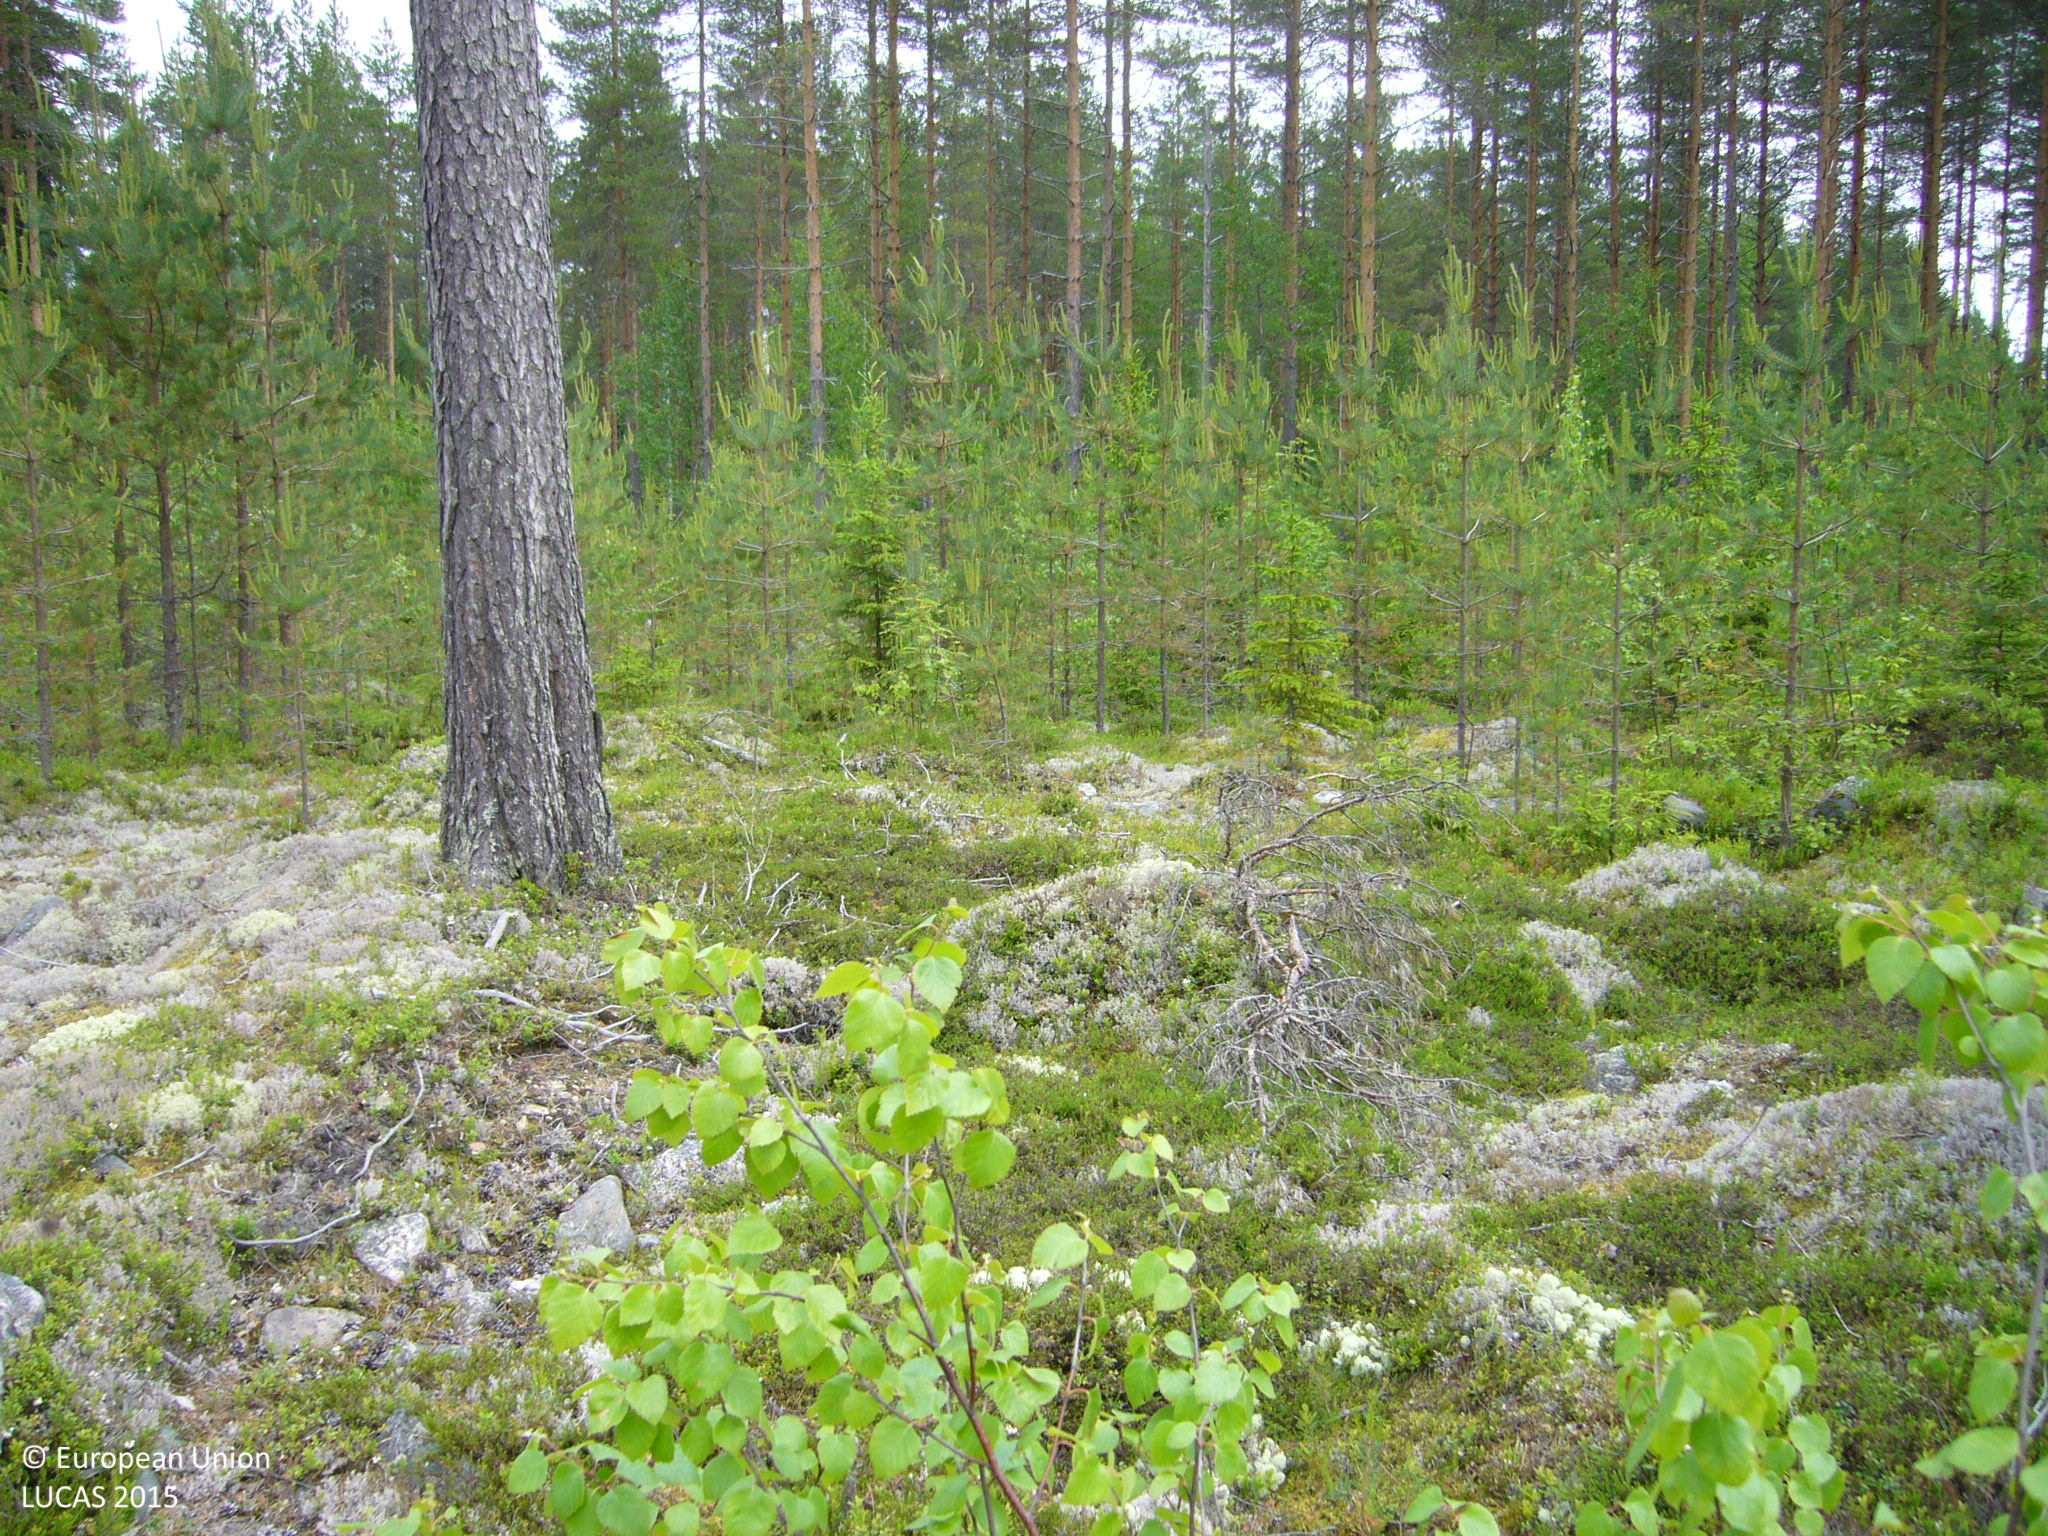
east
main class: Woodland
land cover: Pine dominated coniferous woodland
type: boreal forest
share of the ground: 50 - 75 %
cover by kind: coniferous forest trees 50 %, lichens and mosses 40 %, shrubs 10 %
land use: Forestry
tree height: > 5 m
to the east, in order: Pine dominated coniferous woodland; Ditches and canals; Grass margins; Paved roads, cycling and walking lanes; Grass margins; Ditches and canals; Pine dominated coniferous woodland; Ditches and canals; Pine dominated coniferous woodland; Pine dominated mixed woodland; Ditches and canals; Pine dominated mixed woodland; Pine dominated coniferous woodland
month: July
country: FI
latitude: 63.4349
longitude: 26.1314
